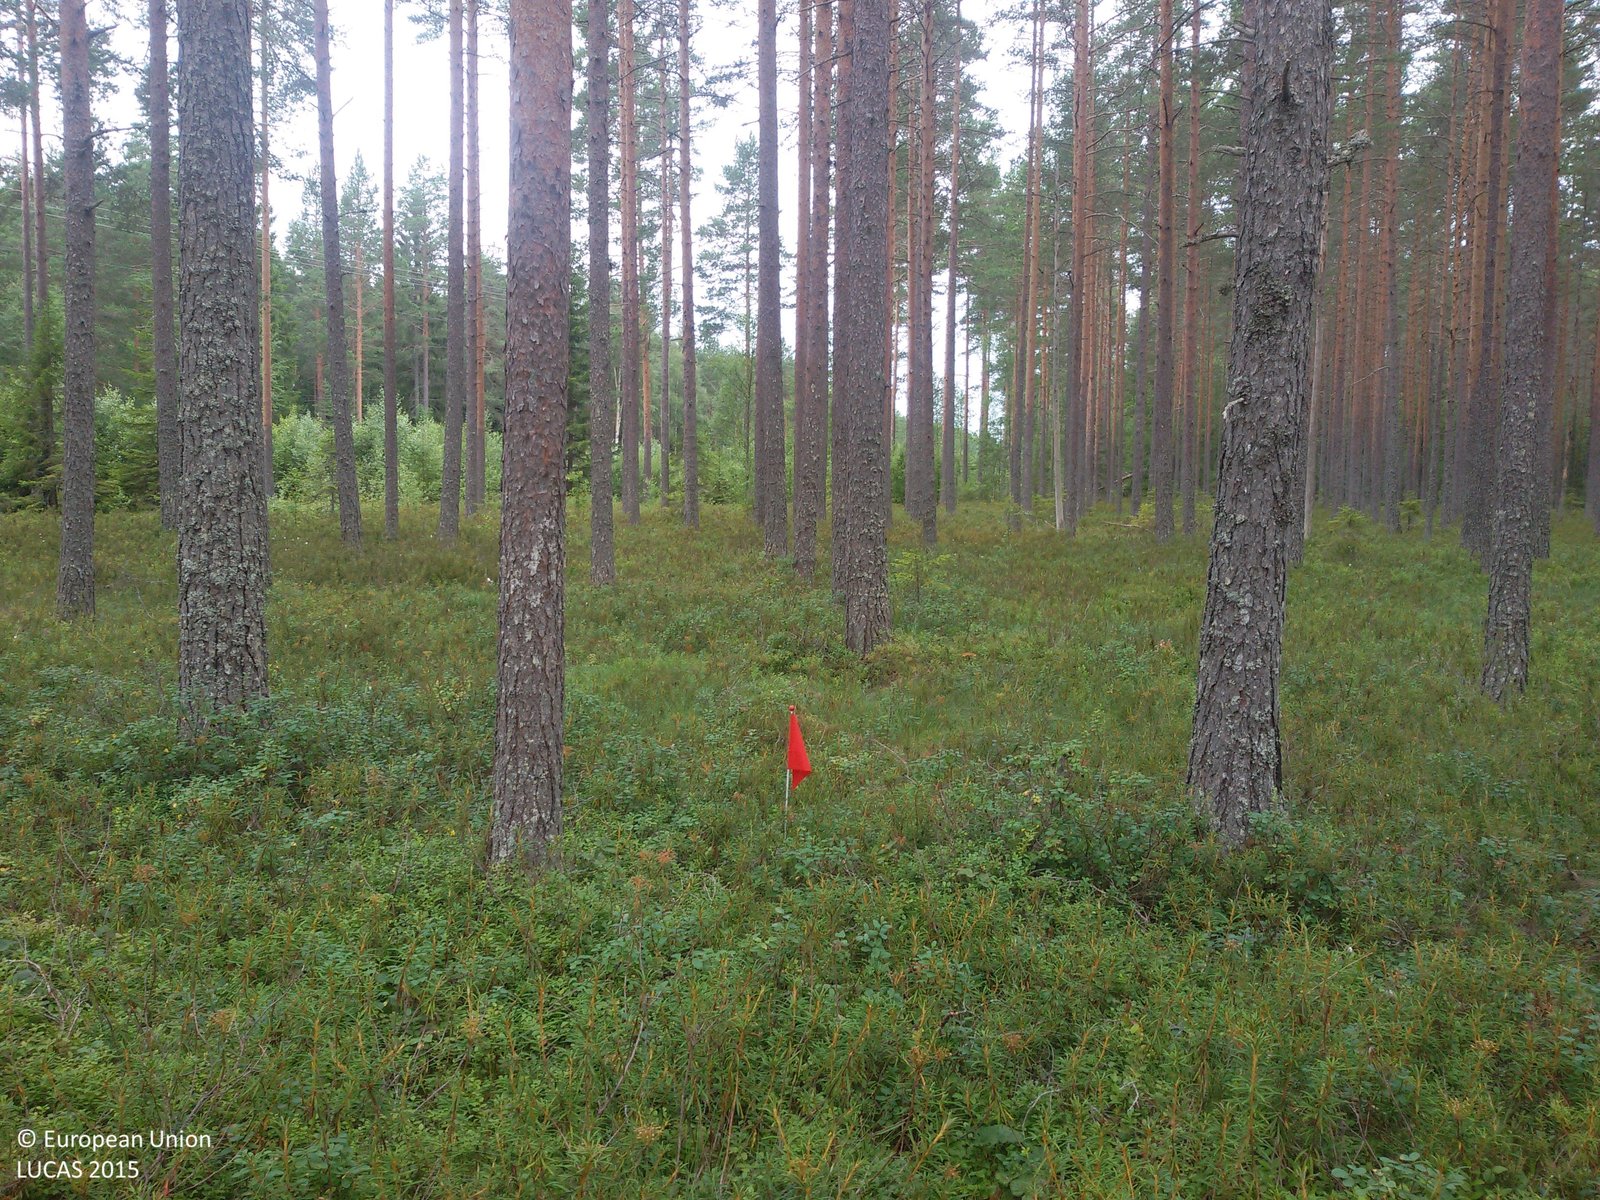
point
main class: Woodland
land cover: Pine dominated coniferous woodland
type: boreal forest
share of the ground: 50 - 75 %
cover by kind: coniferous forest trees 70 %, shrubs 20 %, lichens and mosses 10 %
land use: Forestry
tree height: > 5 m
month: August
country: SE
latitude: 60.7291
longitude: 16.6434
